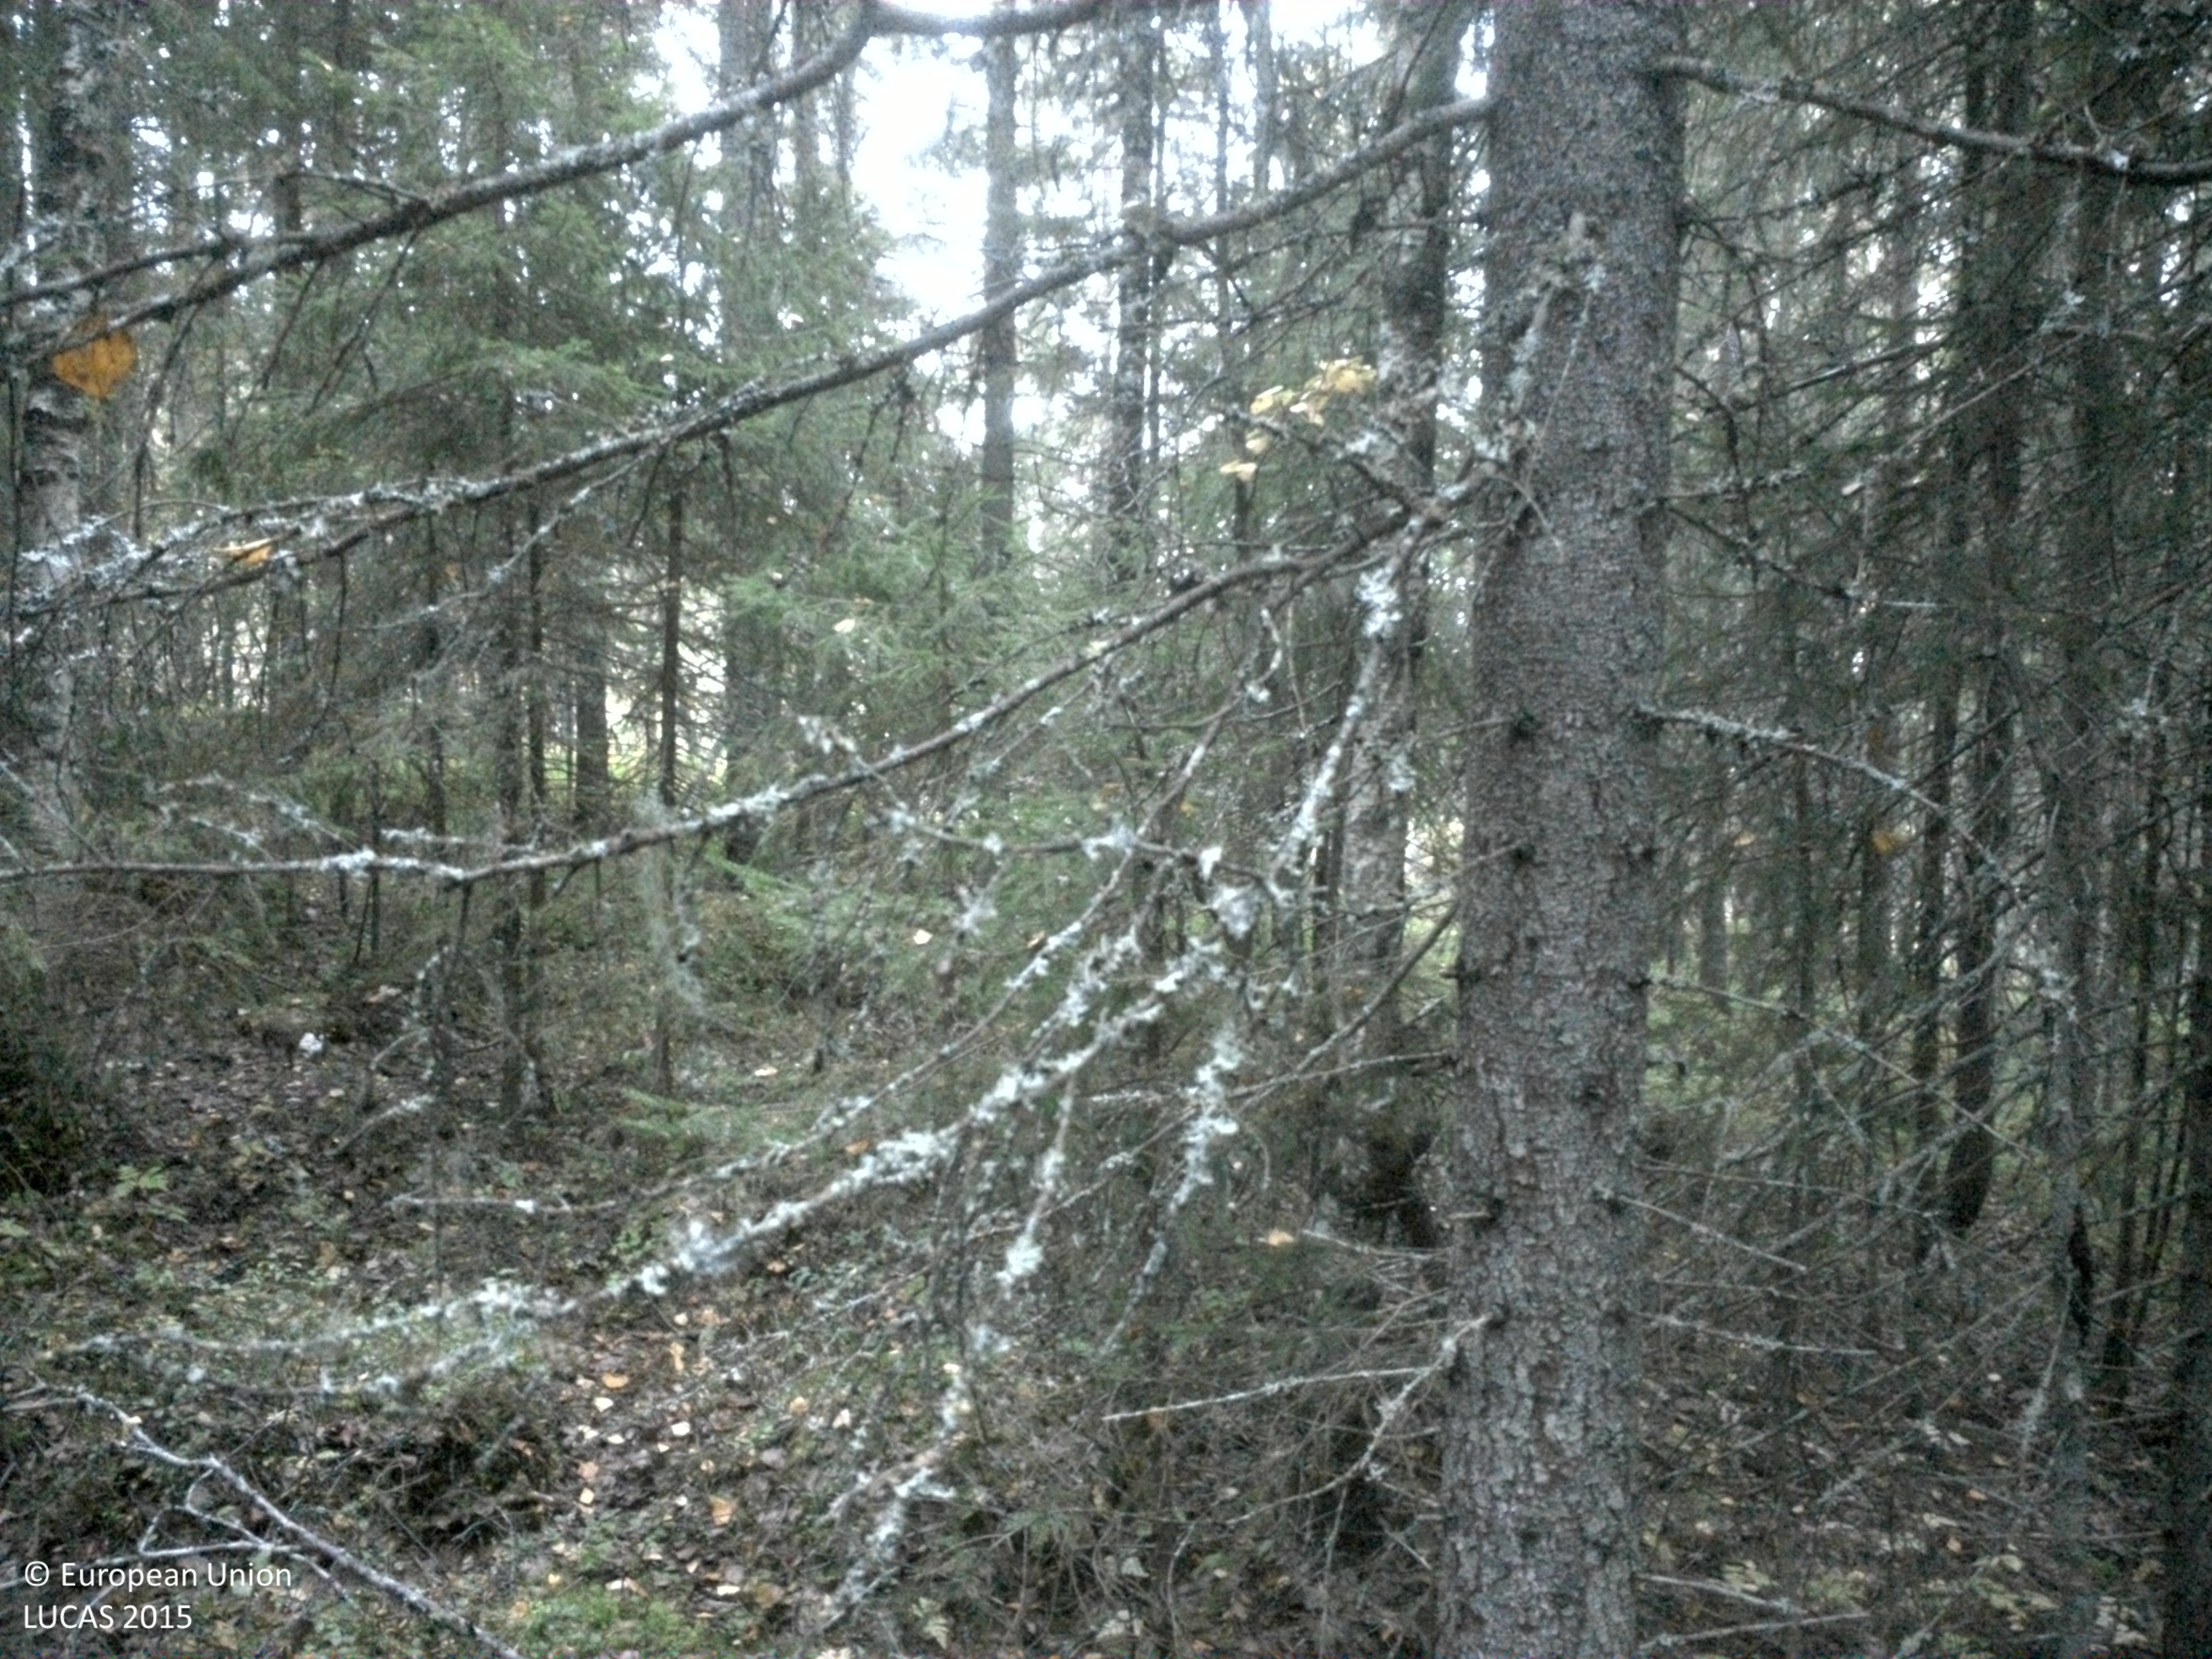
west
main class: Woodland
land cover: Spruce dominated mixed woodland
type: boreal forest
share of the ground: > 75 %
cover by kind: coniferous forest trees 60 %, broadleaved forest trees 20 %, shrubs 10 %, lichens and mosses 10 %
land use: Forestry
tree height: > 5 m
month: September
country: SE
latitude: 64.3197
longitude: 20.5479
